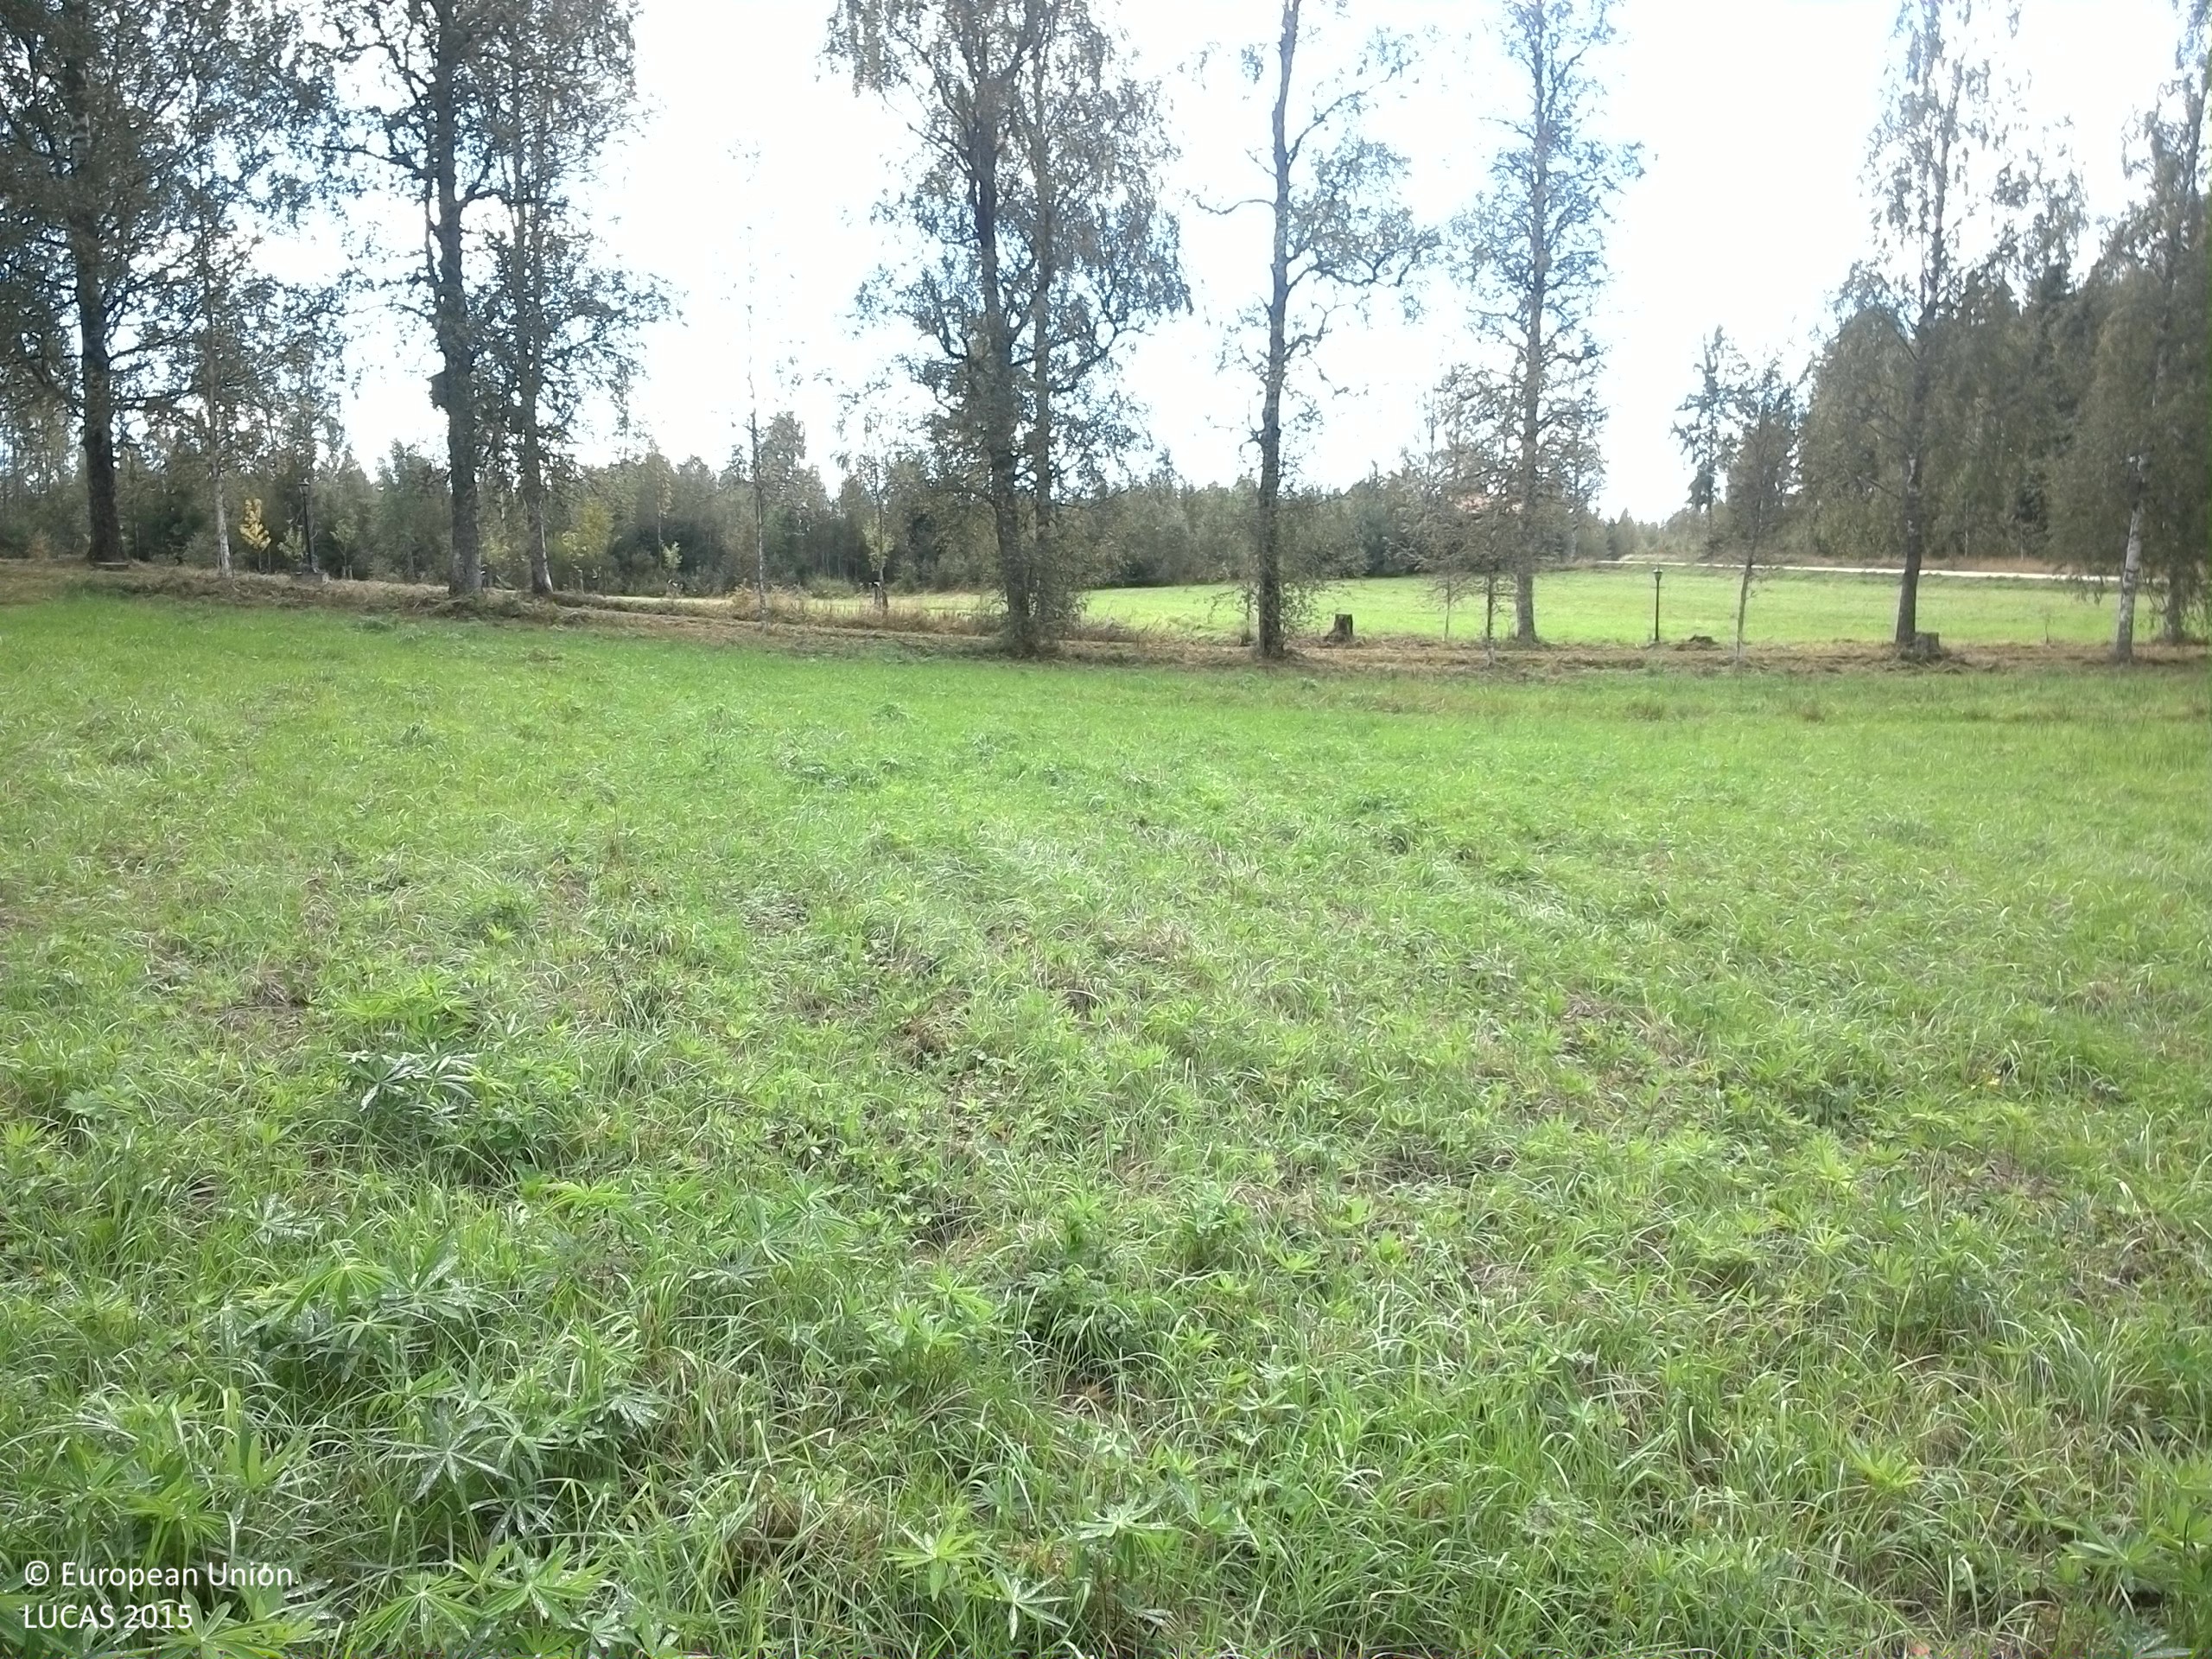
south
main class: Grassland
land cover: Grassland without tree/shrub cover
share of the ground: > 75 %
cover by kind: herbaceous plants 90 %, consolidated bare surface 10 %
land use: Agriculture (excluding fallow land and kitchen gardens)
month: September
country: SE
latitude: 59.7477
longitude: 13.2127
